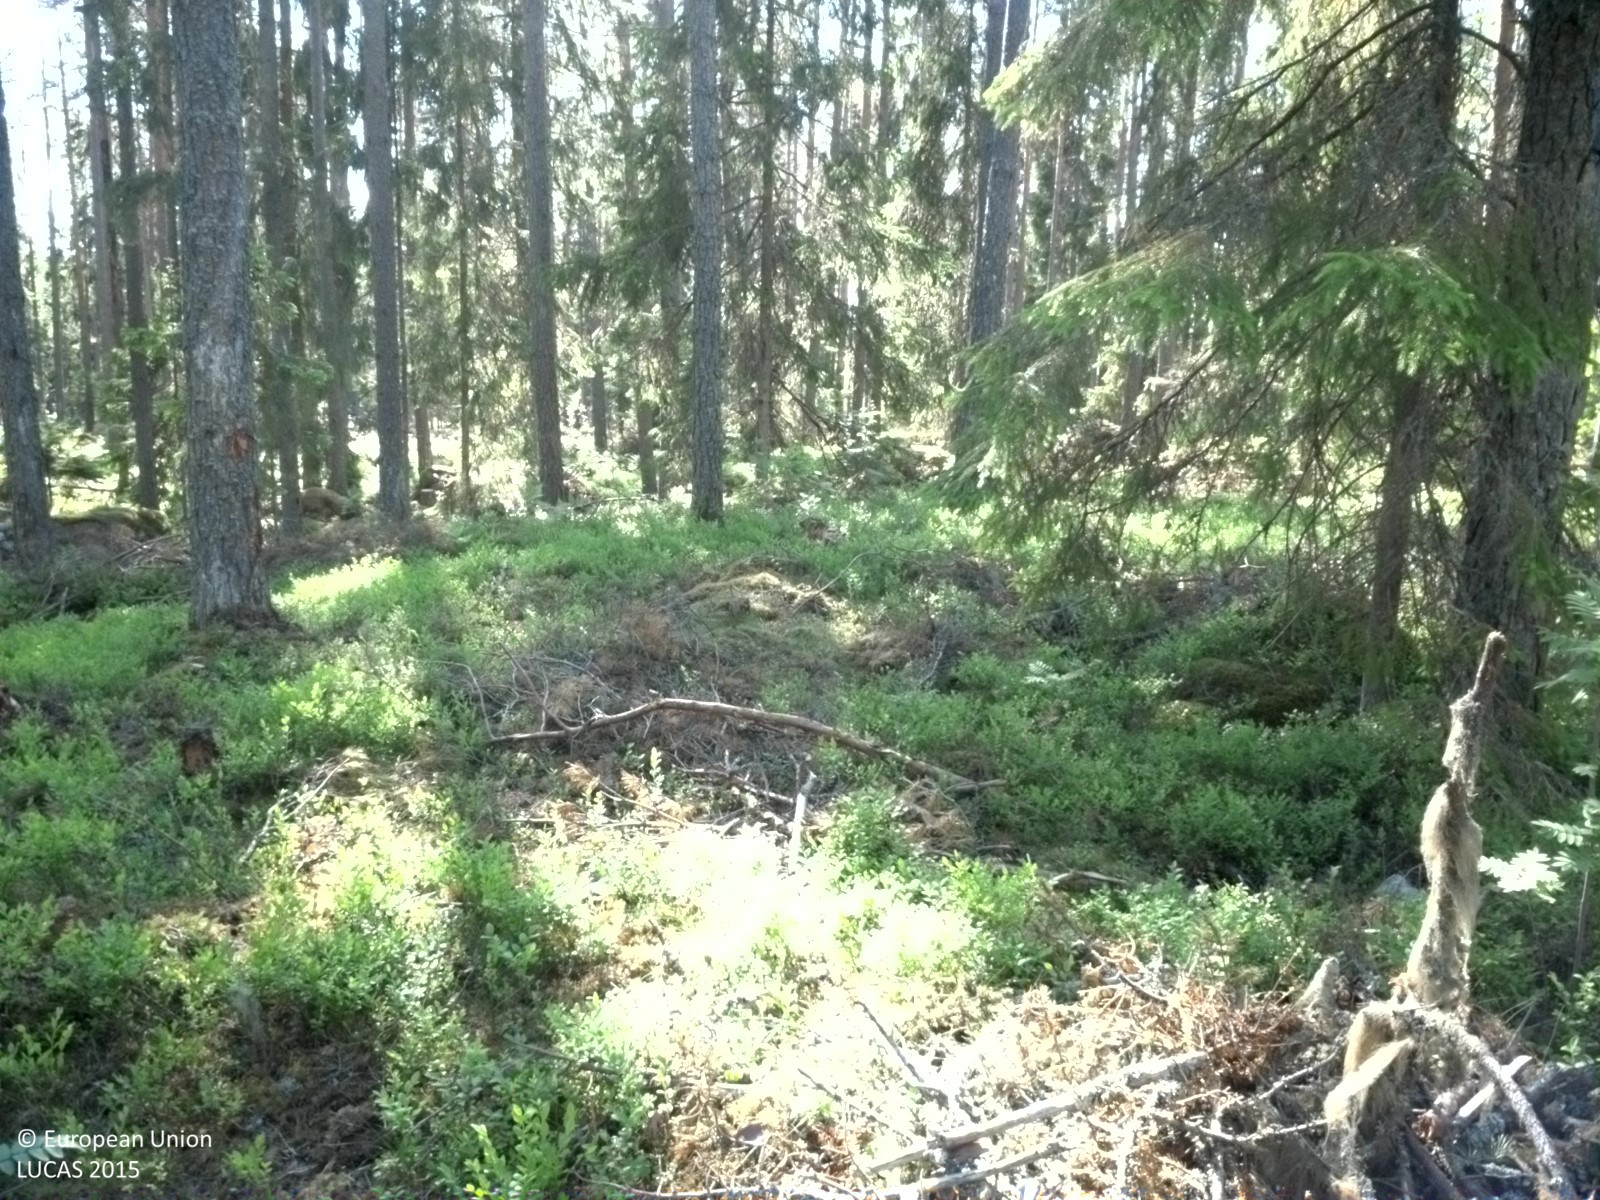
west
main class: Woodland
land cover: Pine dominated coniferous woodland
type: boreal forest
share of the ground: 50 - 75 %
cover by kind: coniferous forest trees 50 %, shrubs 20 %, consolidated bare surface 10 %, herbaceous plants 5 %, lichens and mosses 5 %
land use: Forestry
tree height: > 5 m
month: June
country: SE
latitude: 60.1699
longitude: 17.6888
